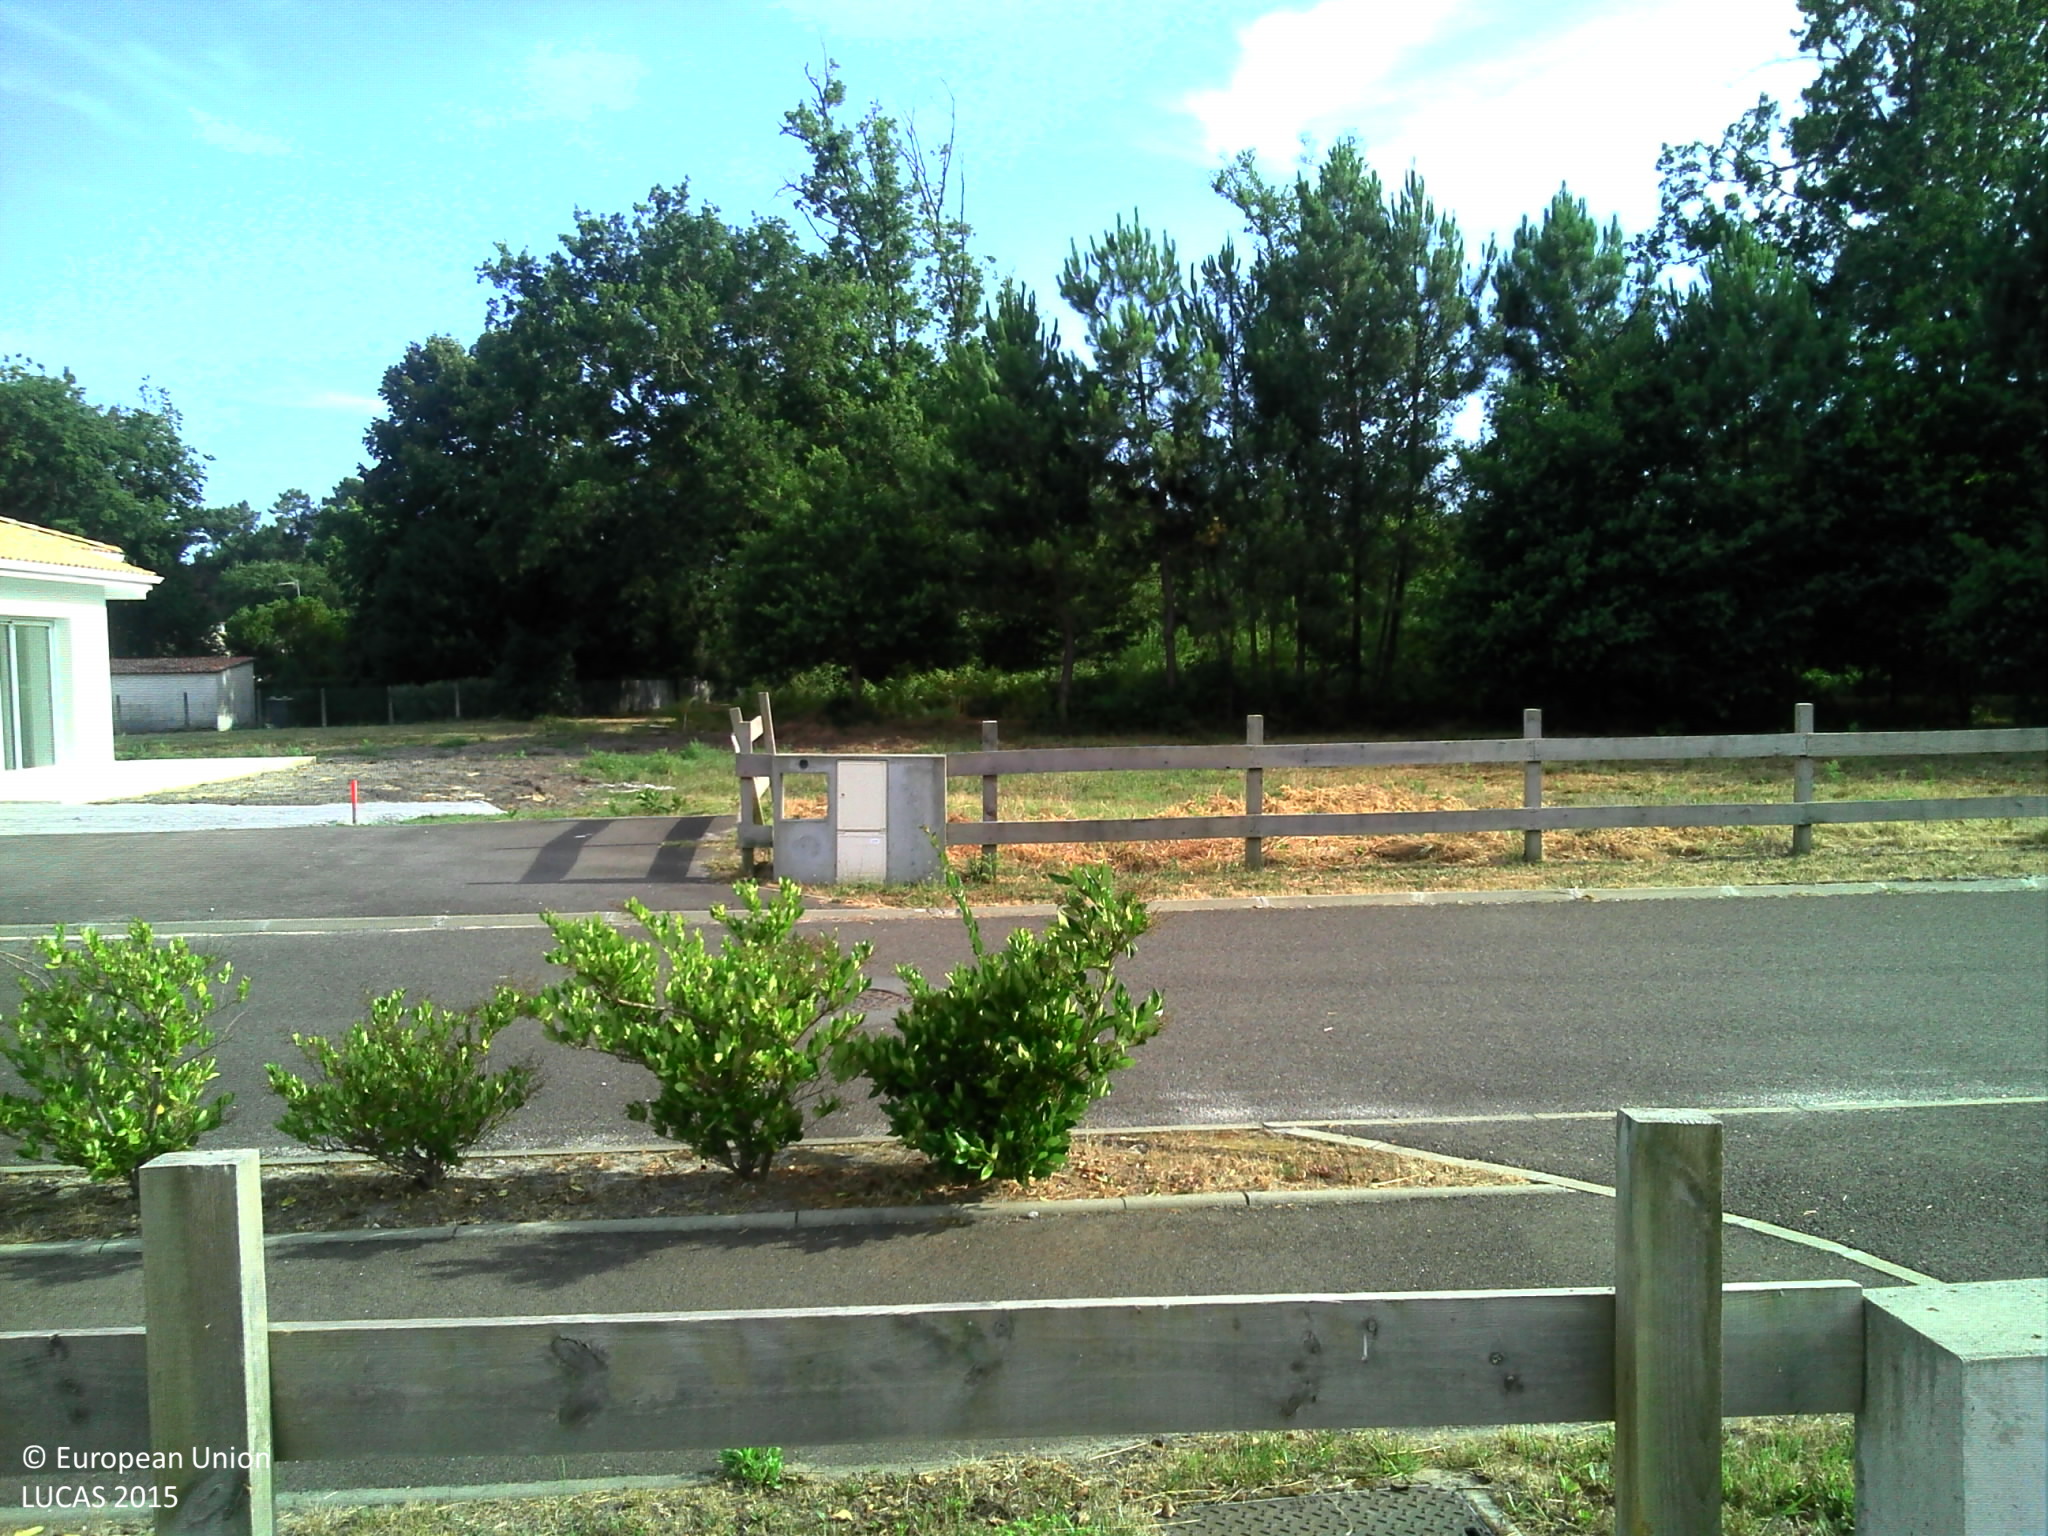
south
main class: Grassland
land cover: Grassland without tree/shrub cover
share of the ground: > 75 %
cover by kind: herbaceous plants 100 %
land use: Residential
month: July
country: FR
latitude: 43.9117
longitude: -1.3141
